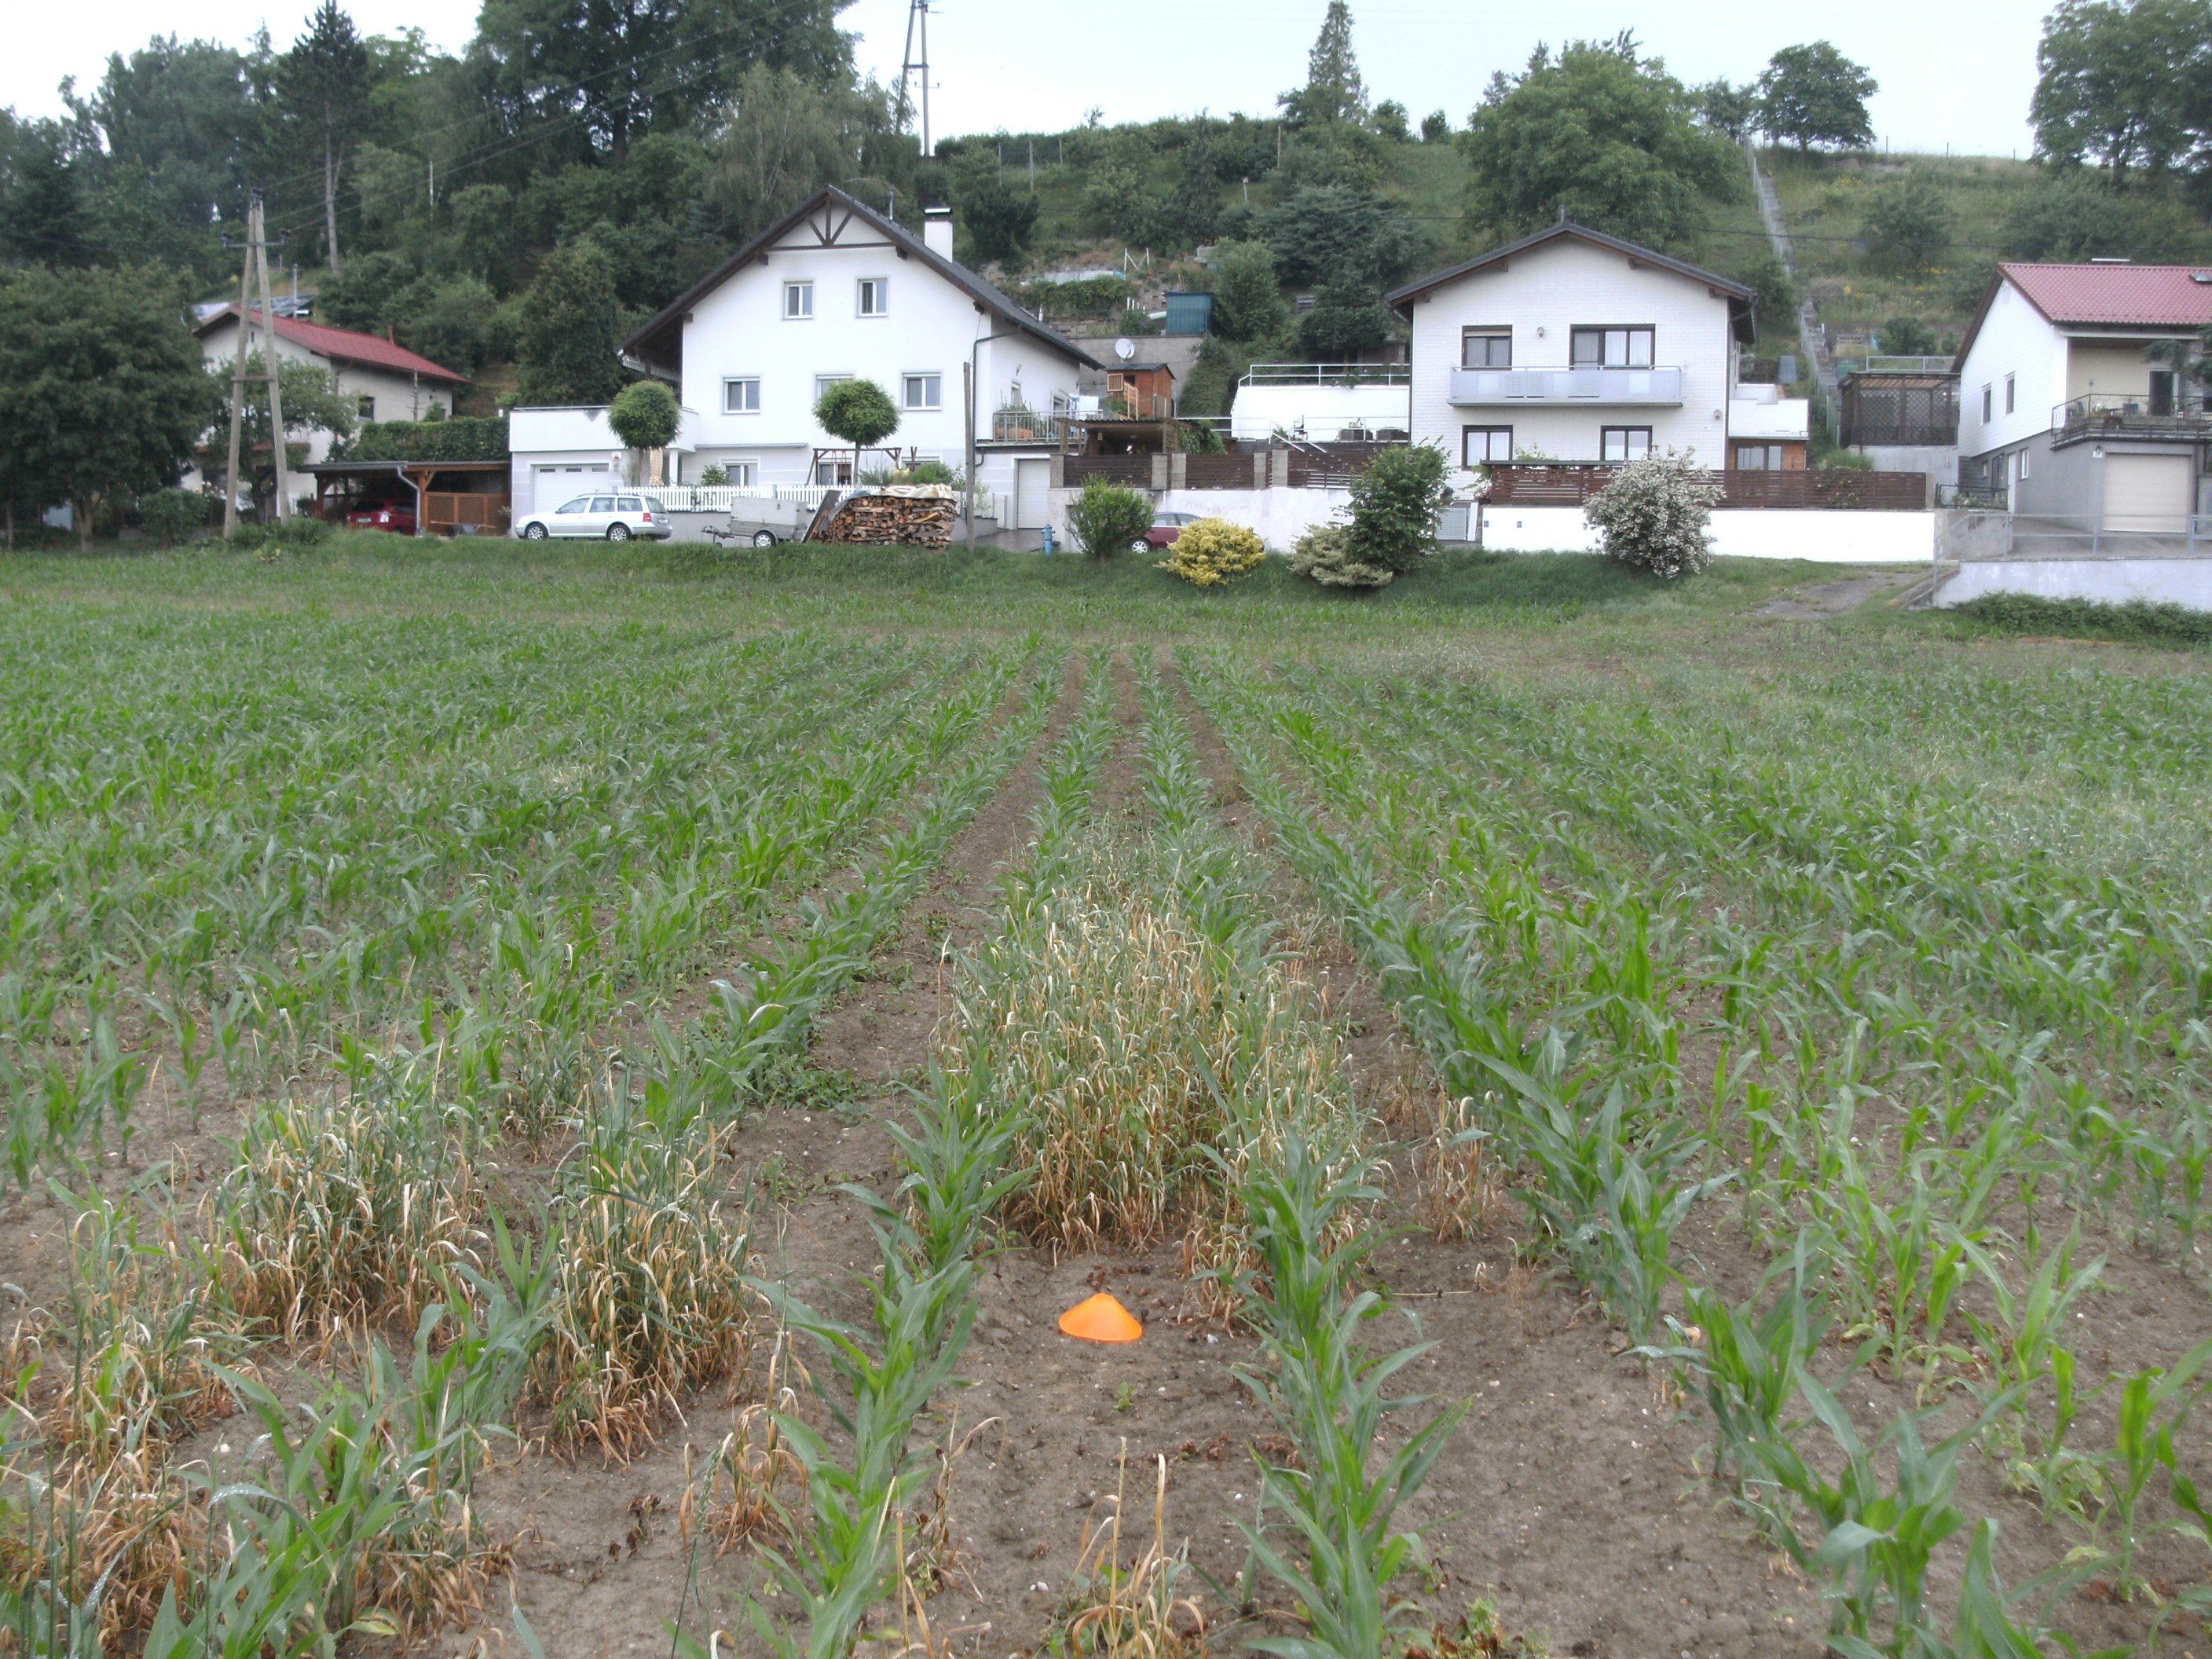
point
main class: Cropland
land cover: Maize
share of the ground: 25 - 50 %
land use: Agriculture (excluding fallow land and kitchen gardens)
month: June
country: AT
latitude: 48.3449
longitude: 14.1152
